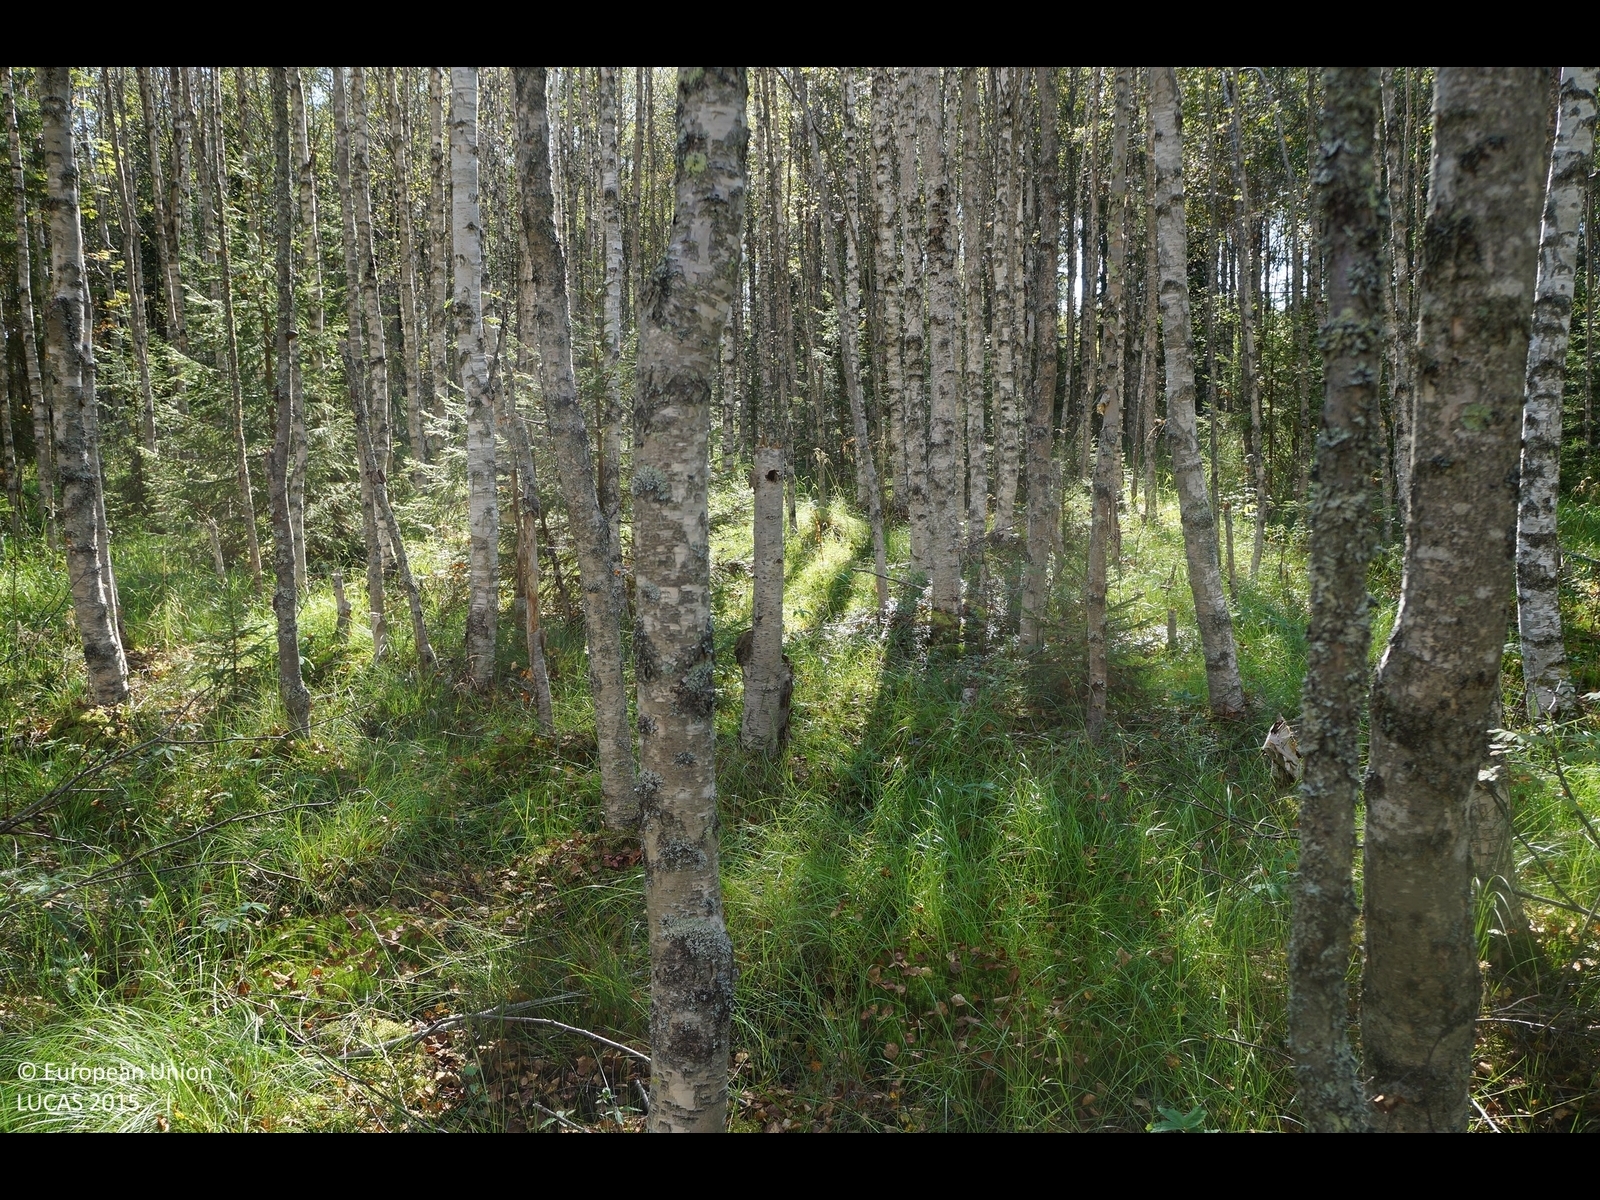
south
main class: Woodland
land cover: Broadleaved woodland
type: boreal forest
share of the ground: 50 - 75 %
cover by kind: broadleaved forest trees 60 %, herbaceous plants 15 %, lichens and mosses 15 %, coniferous forest trees 5 %, shrubs 5 %
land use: Forestry
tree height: > 5 m
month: August
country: FI
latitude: 64.4332
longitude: 25.2244
